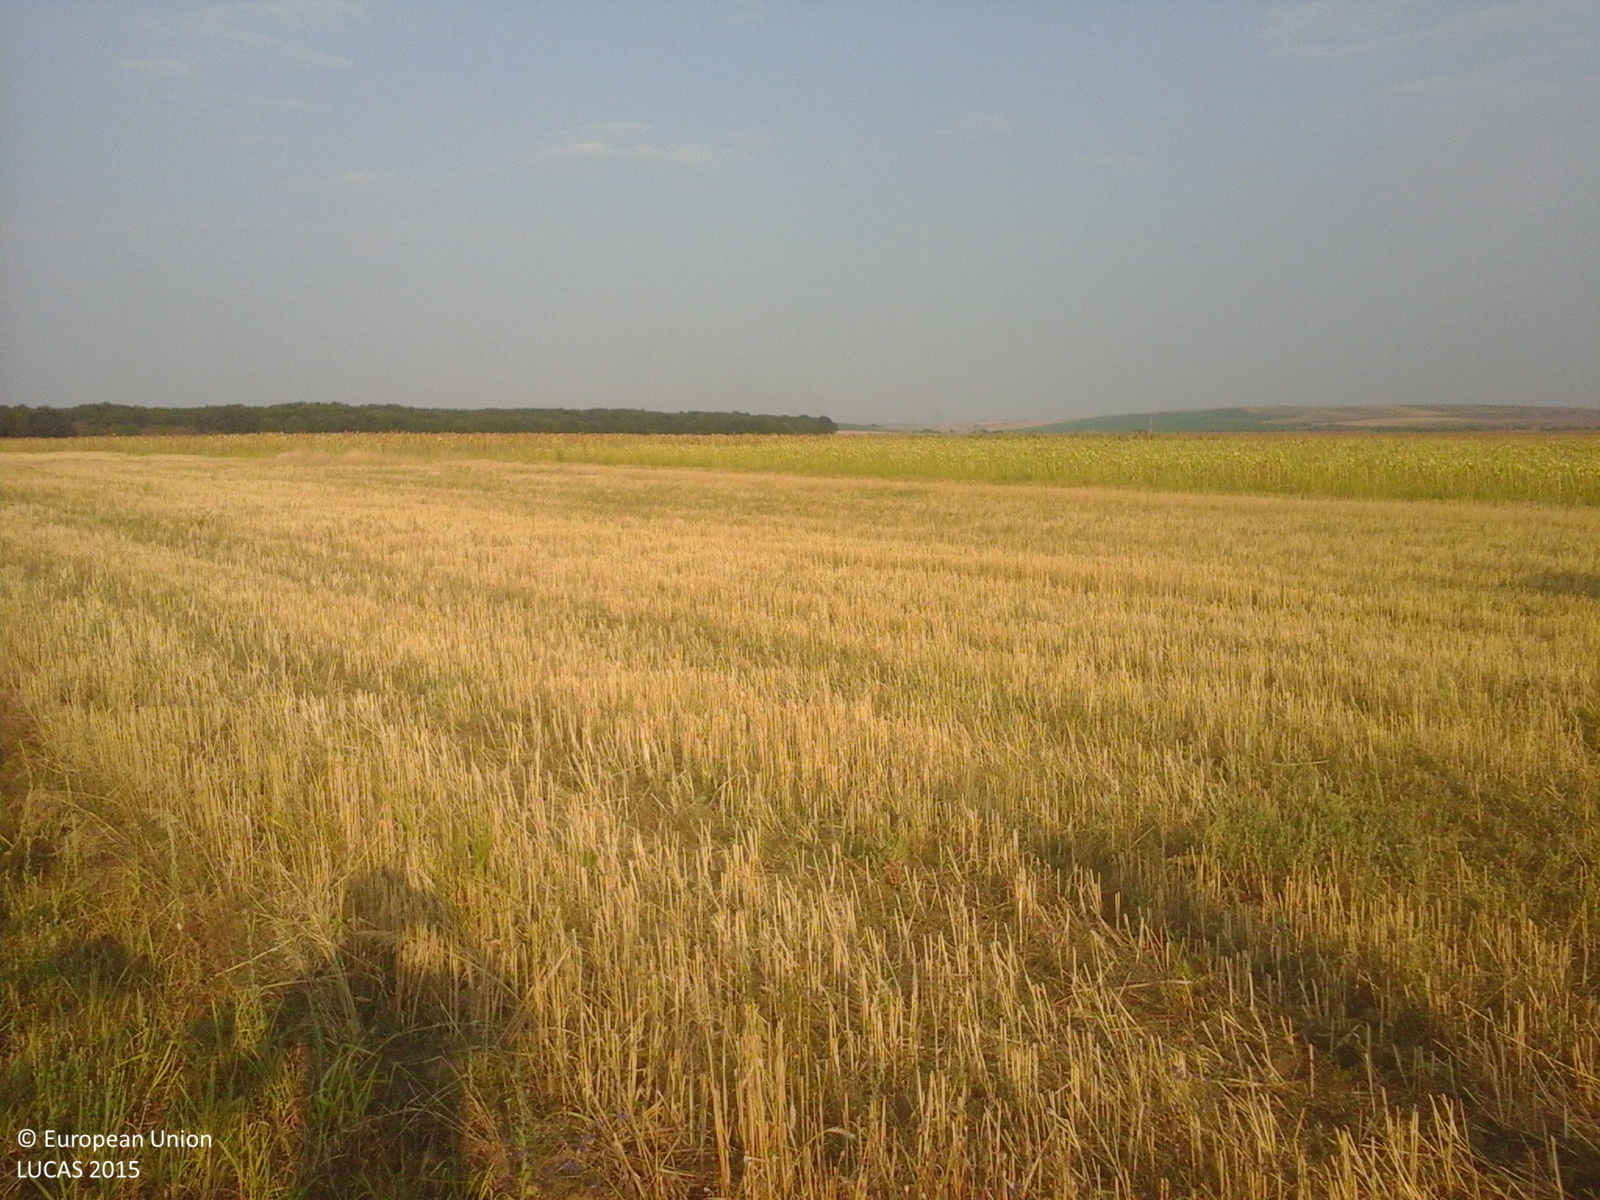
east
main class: Cropland
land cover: Sunflower
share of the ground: > 75 %
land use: Agriculture (excluding fallow land and kitchen gardens)
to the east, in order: Sunflower; Common wheat; Grass margins; Tracks; Grass margins; Common wheat; Sunflower
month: August
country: RO
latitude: 44.3173
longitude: 22.9702
